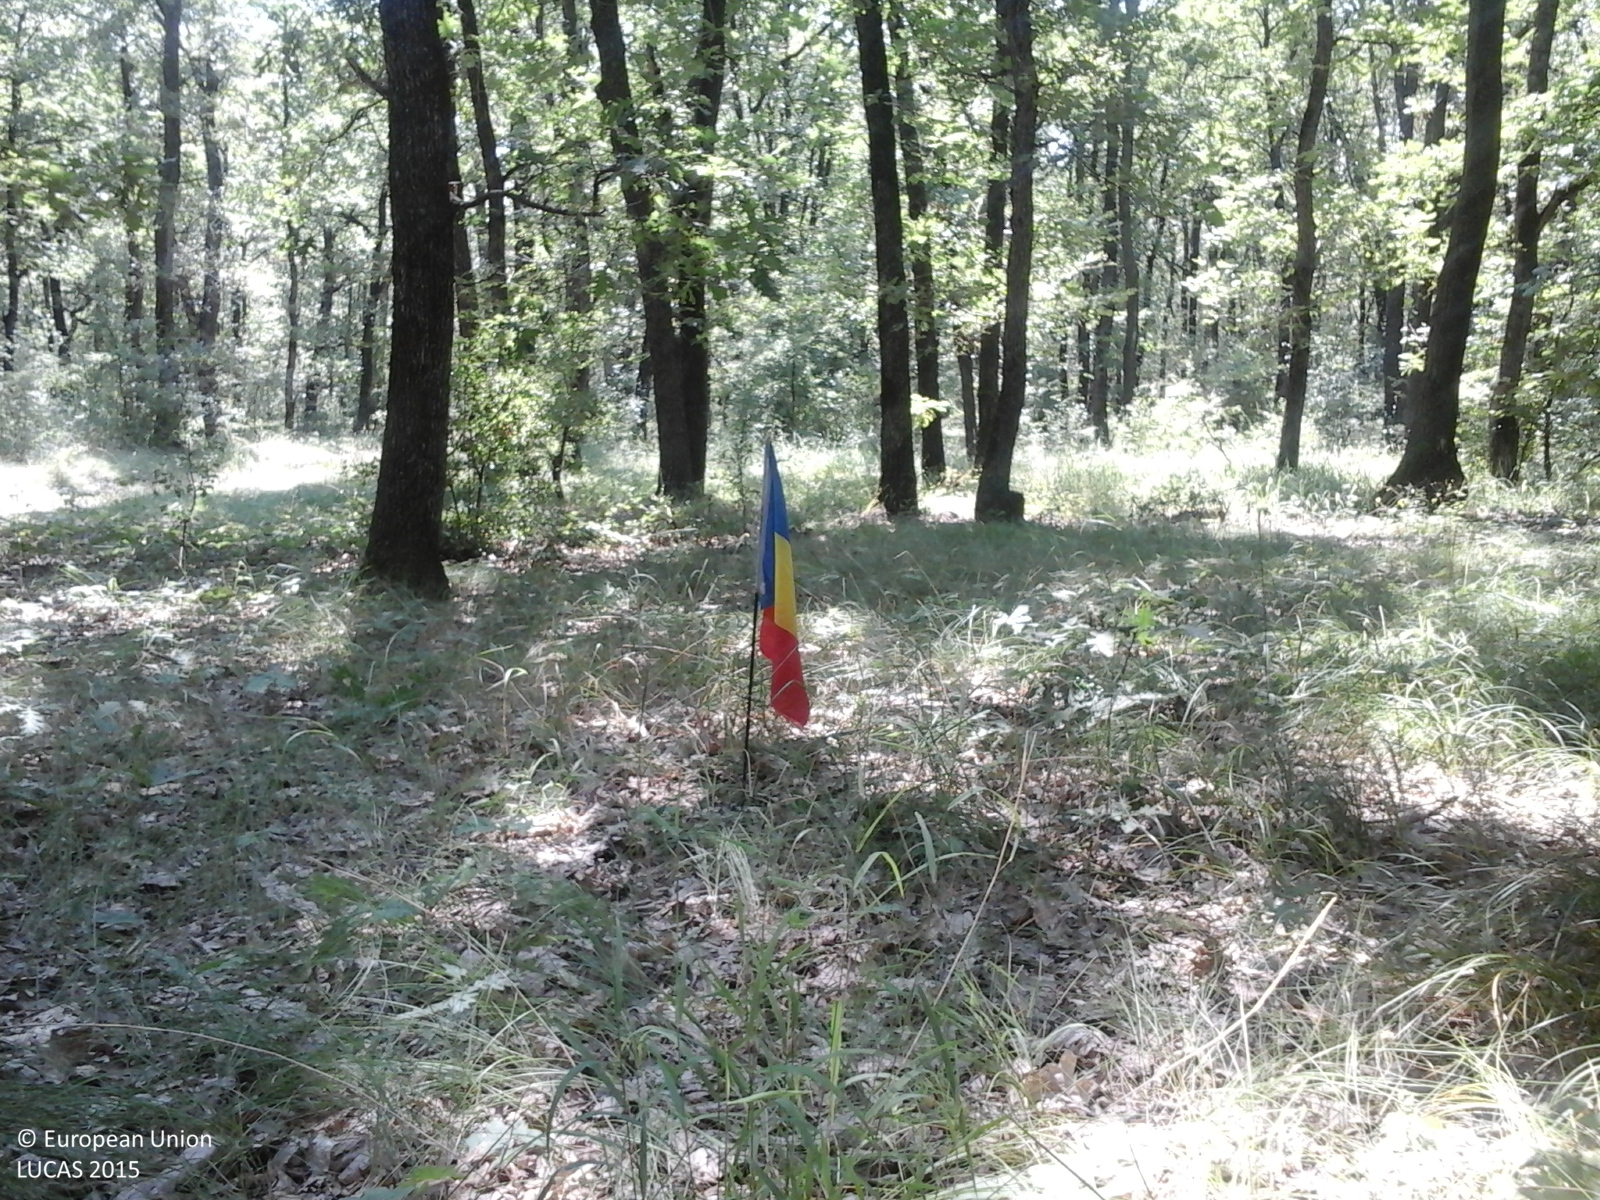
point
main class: Woodland
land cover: Broadleaved woodland
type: acidophilous oak and oak-birch forest
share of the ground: > 75 %
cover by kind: broadleaved forest trees 100 %
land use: Forestry
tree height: > 5 m
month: July
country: RO
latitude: 44.0764
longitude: 25.2539
